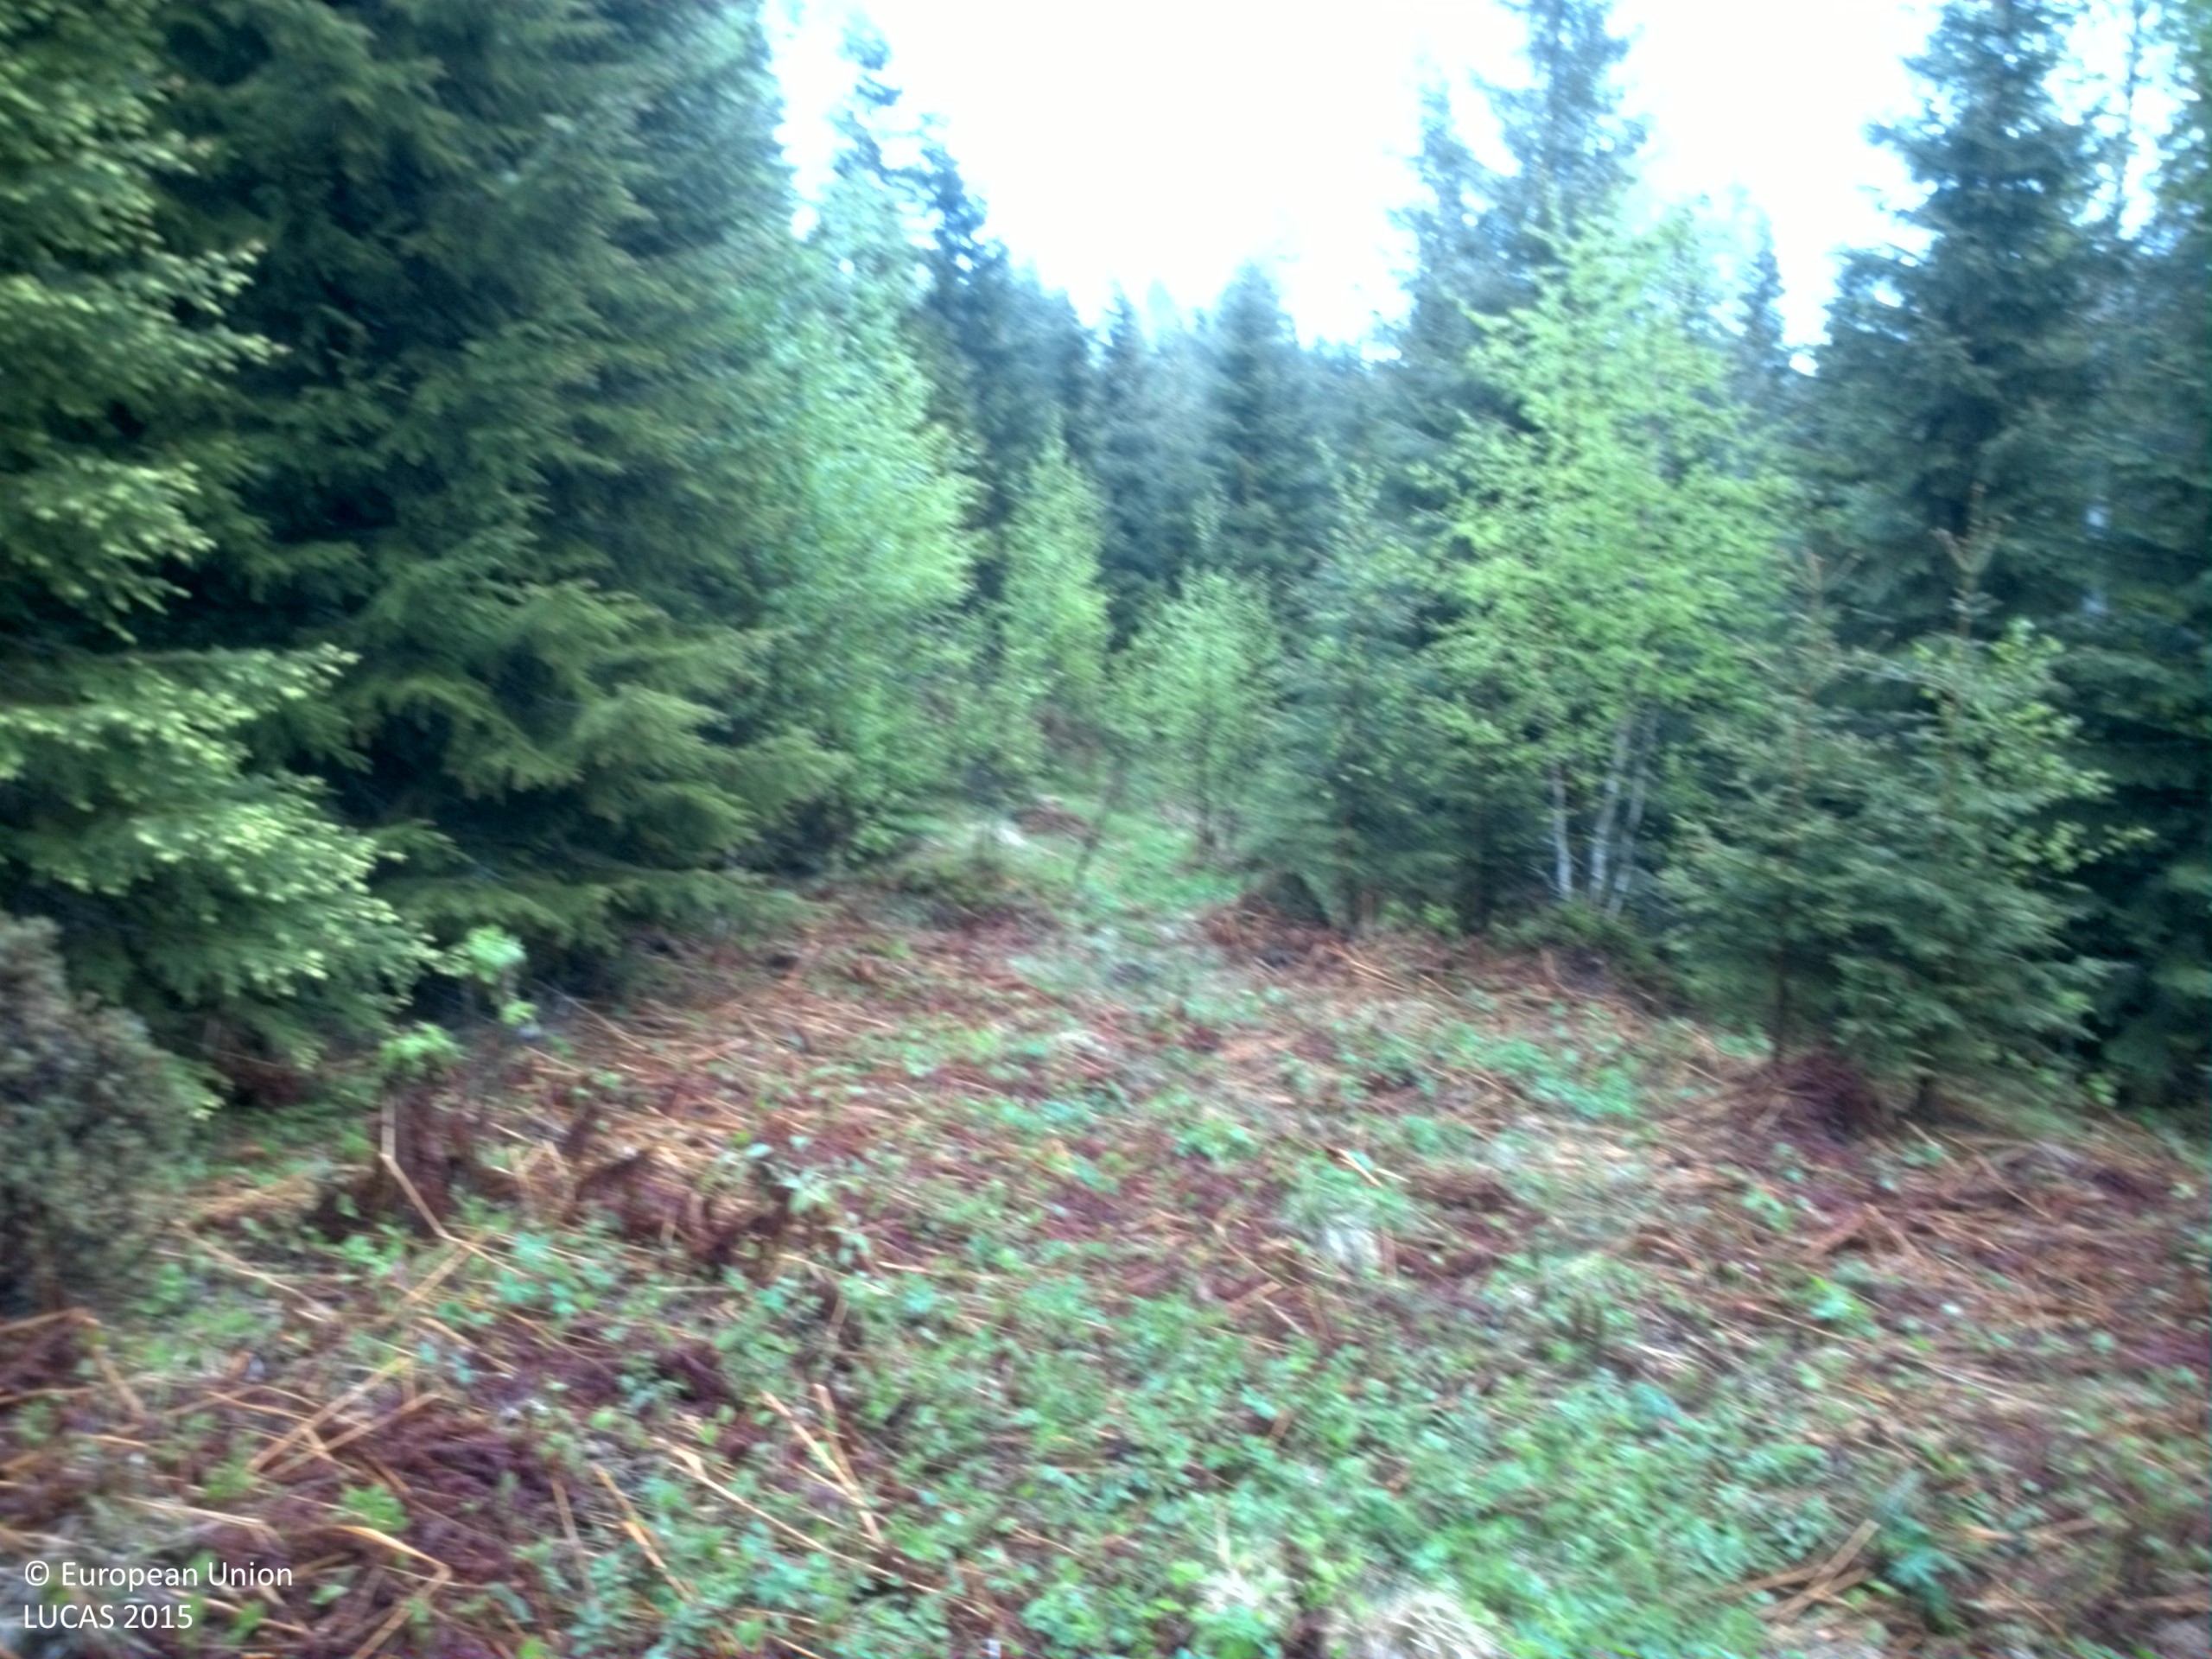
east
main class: Woodland
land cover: Spruce dominated mixed woodland
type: boreal forest
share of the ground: 50 - 75 %
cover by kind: coniferous forest trees 45 %, herbaceous plants 30 %, broadleaved forest trees 15 %, shrubs 10 %
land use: Forestry
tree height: < 5 m
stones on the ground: 25 - 50 %
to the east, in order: Spruce dominated mixed woodland; Spruce dominated coniferous woodland
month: May
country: SE
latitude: 63.0672
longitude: 17.7146
